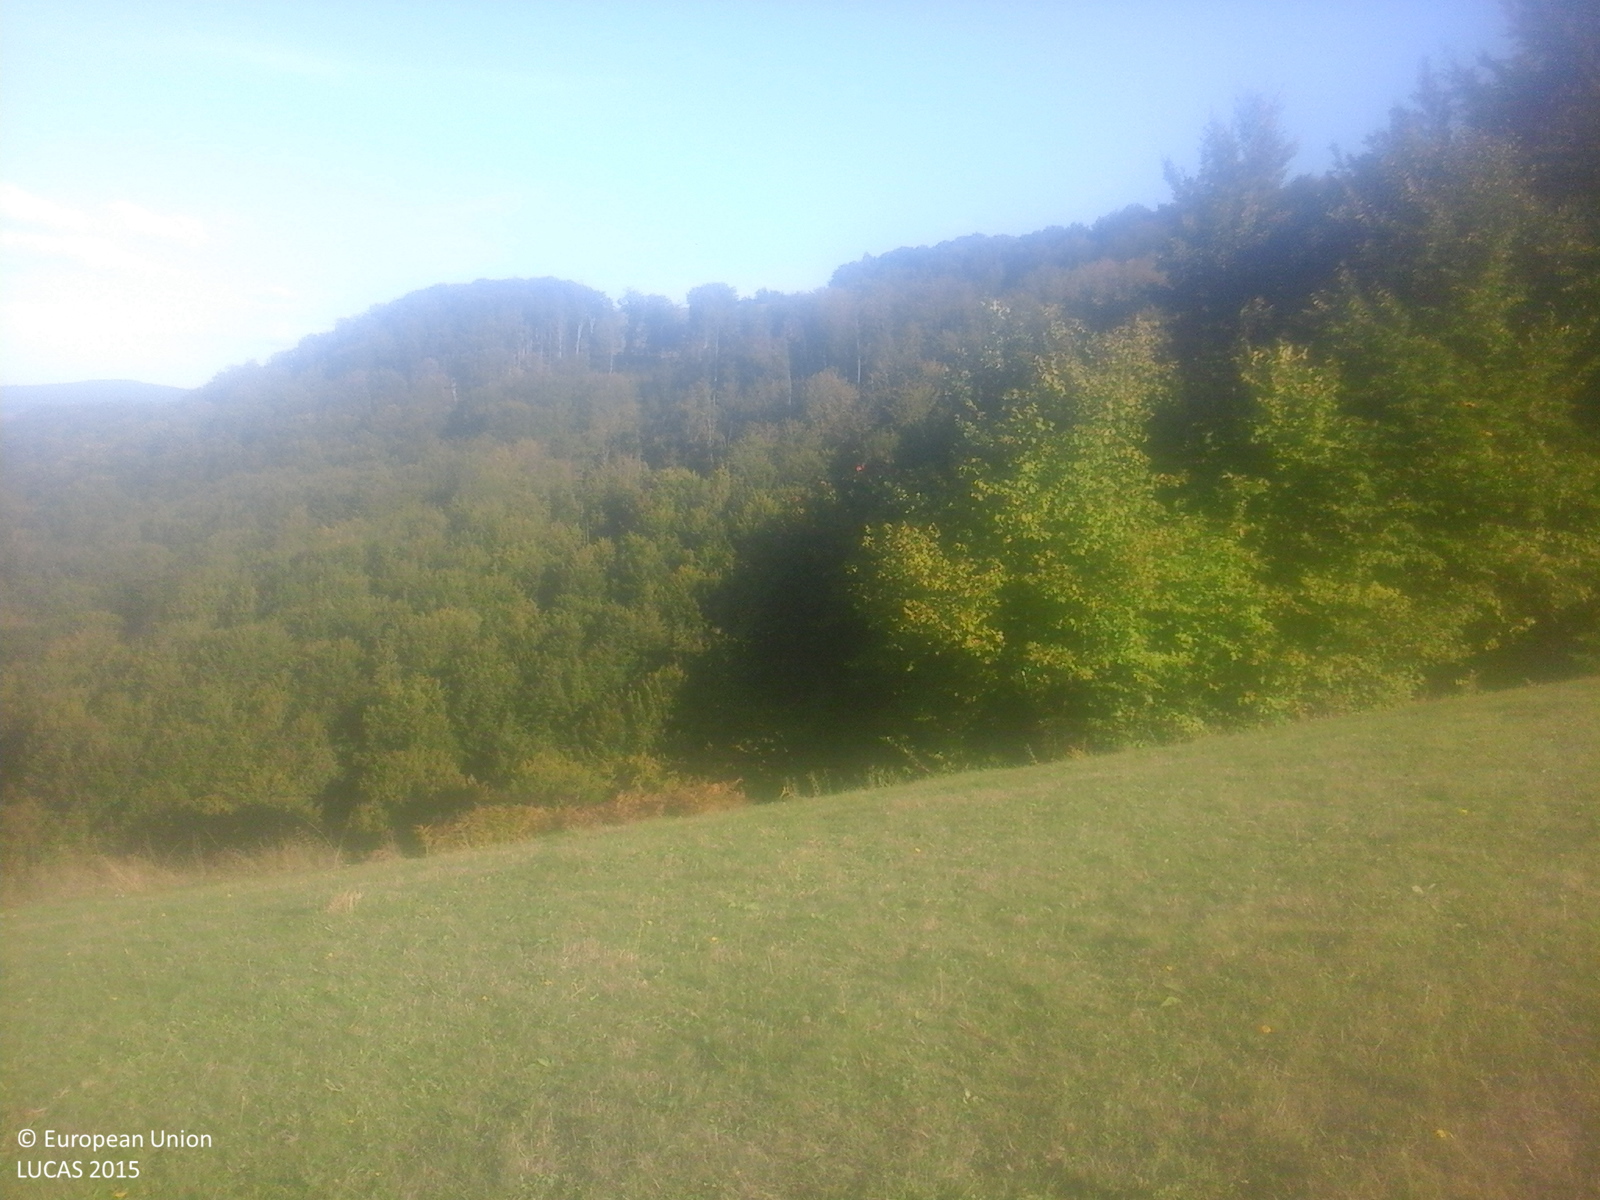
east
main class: Grassland
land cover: Grassland without tree/shrub cover
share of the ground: > 75 %
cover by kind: herbaceous plants 100 %
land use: Agriculture (excluding fallow land and kitchen gardens)
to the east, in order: Grassland without tree/shrub cover; Shruby margins; Grassland without tree/shrub cover; Shruby margins; Fences; Grassland without tree/shrub cover; Tracks; Grassland without tree/shrub cover; Spruce dominated coniferous woodland; Inland fresh running water; Spruce dominated coniferous woodland
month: October
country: RO
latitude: 46.2355
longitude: 23.0915
